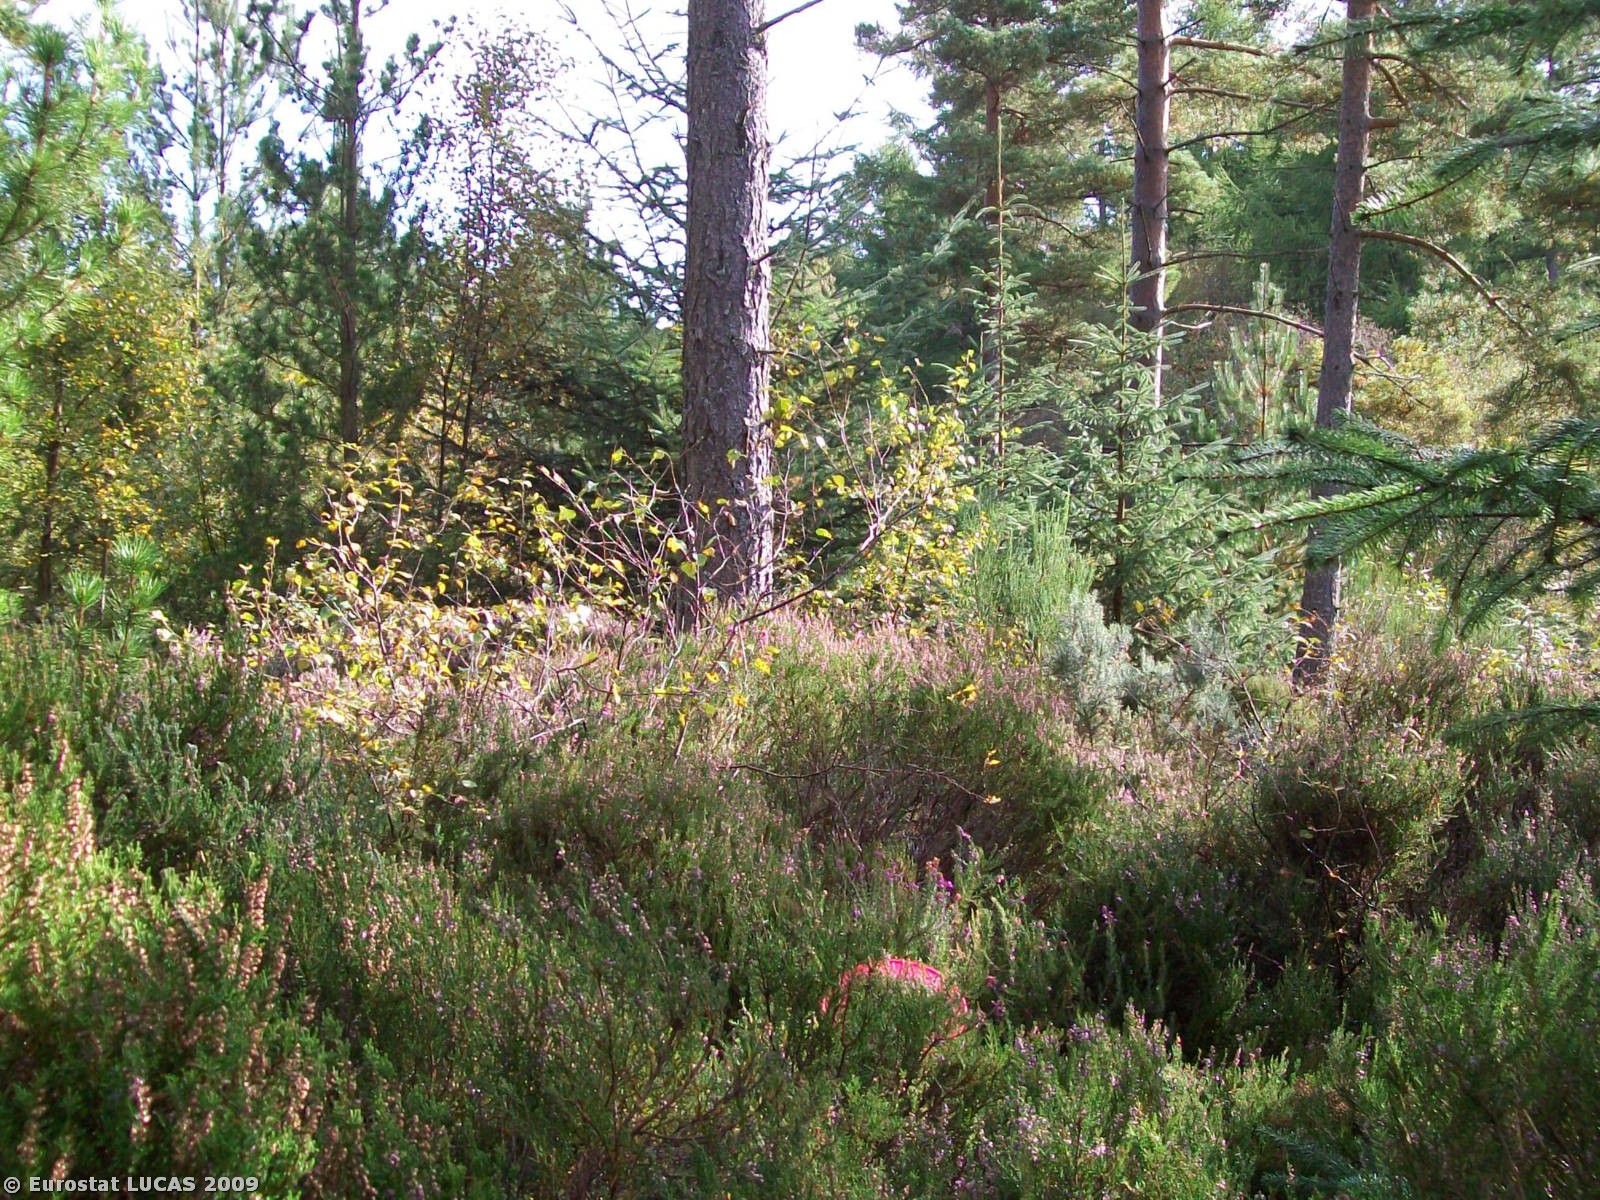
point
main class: Woodland
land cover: Coniferous woodland
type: plantations and self-sown exotic forest
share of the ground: 50 - 75 %
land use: Forestry
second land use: Forestry
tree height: > 5 m
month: September
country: GB
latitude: 57.2854
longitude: -2.5130
